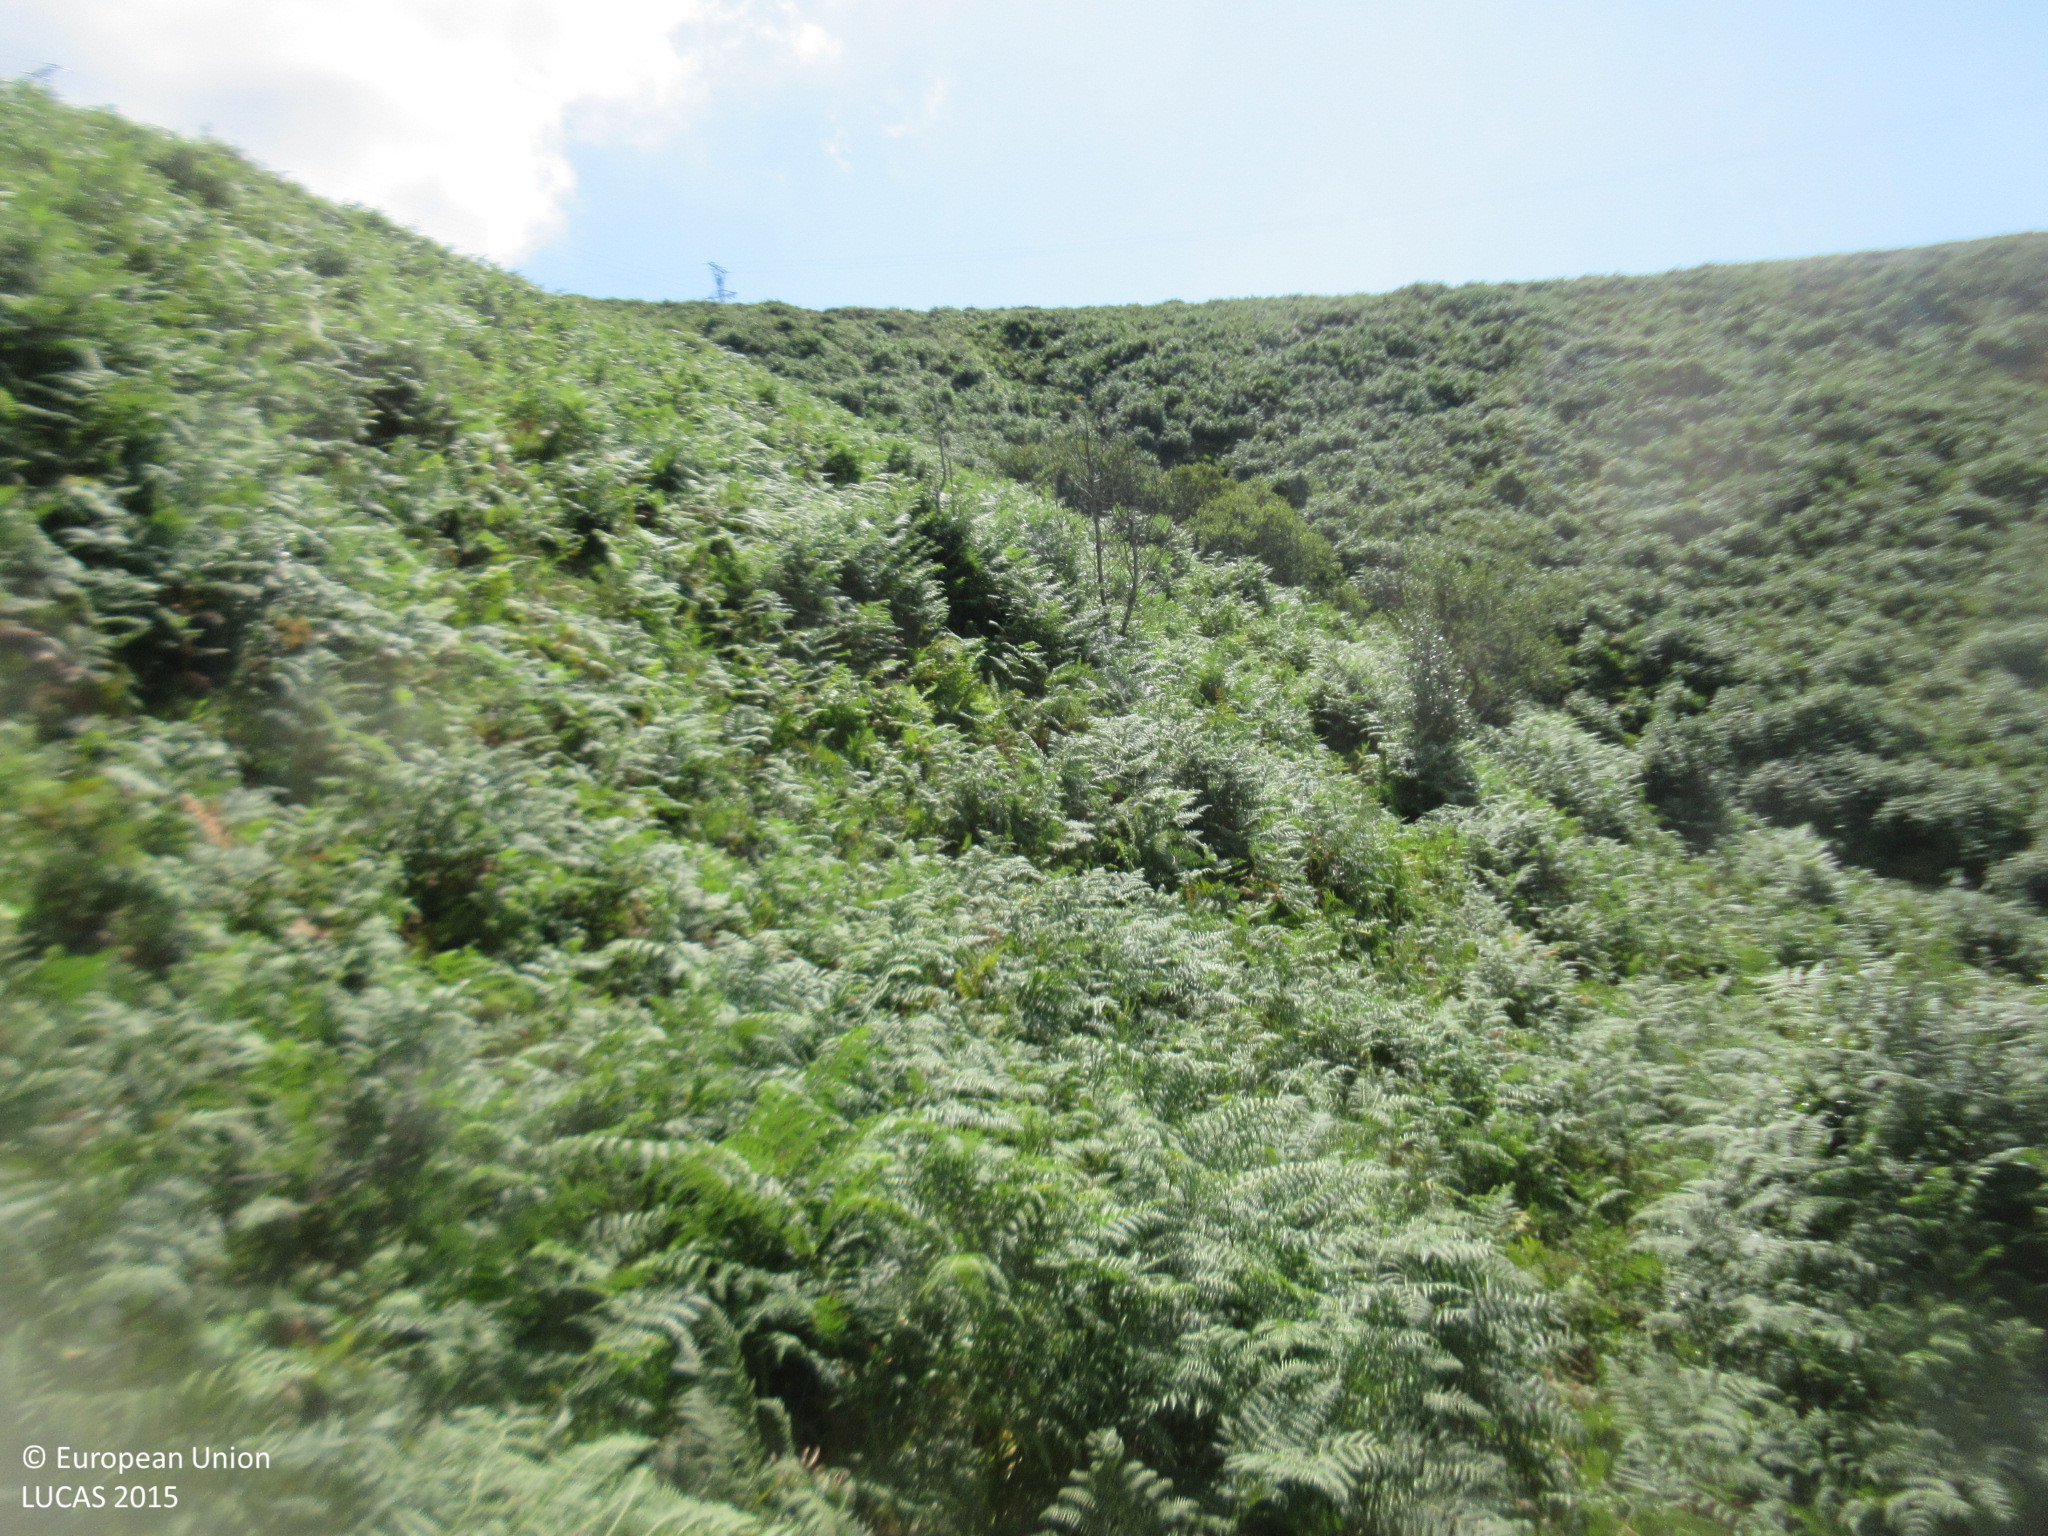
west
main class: Grassland
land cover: Grassland without tree/shrub cover
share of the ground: > 75 %
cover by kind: herbaceous plants 100 %
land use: Agriculture (excluding fallow land and kitchen gardens)
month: July
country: ES
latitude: 43.1208
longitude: -3.8742
